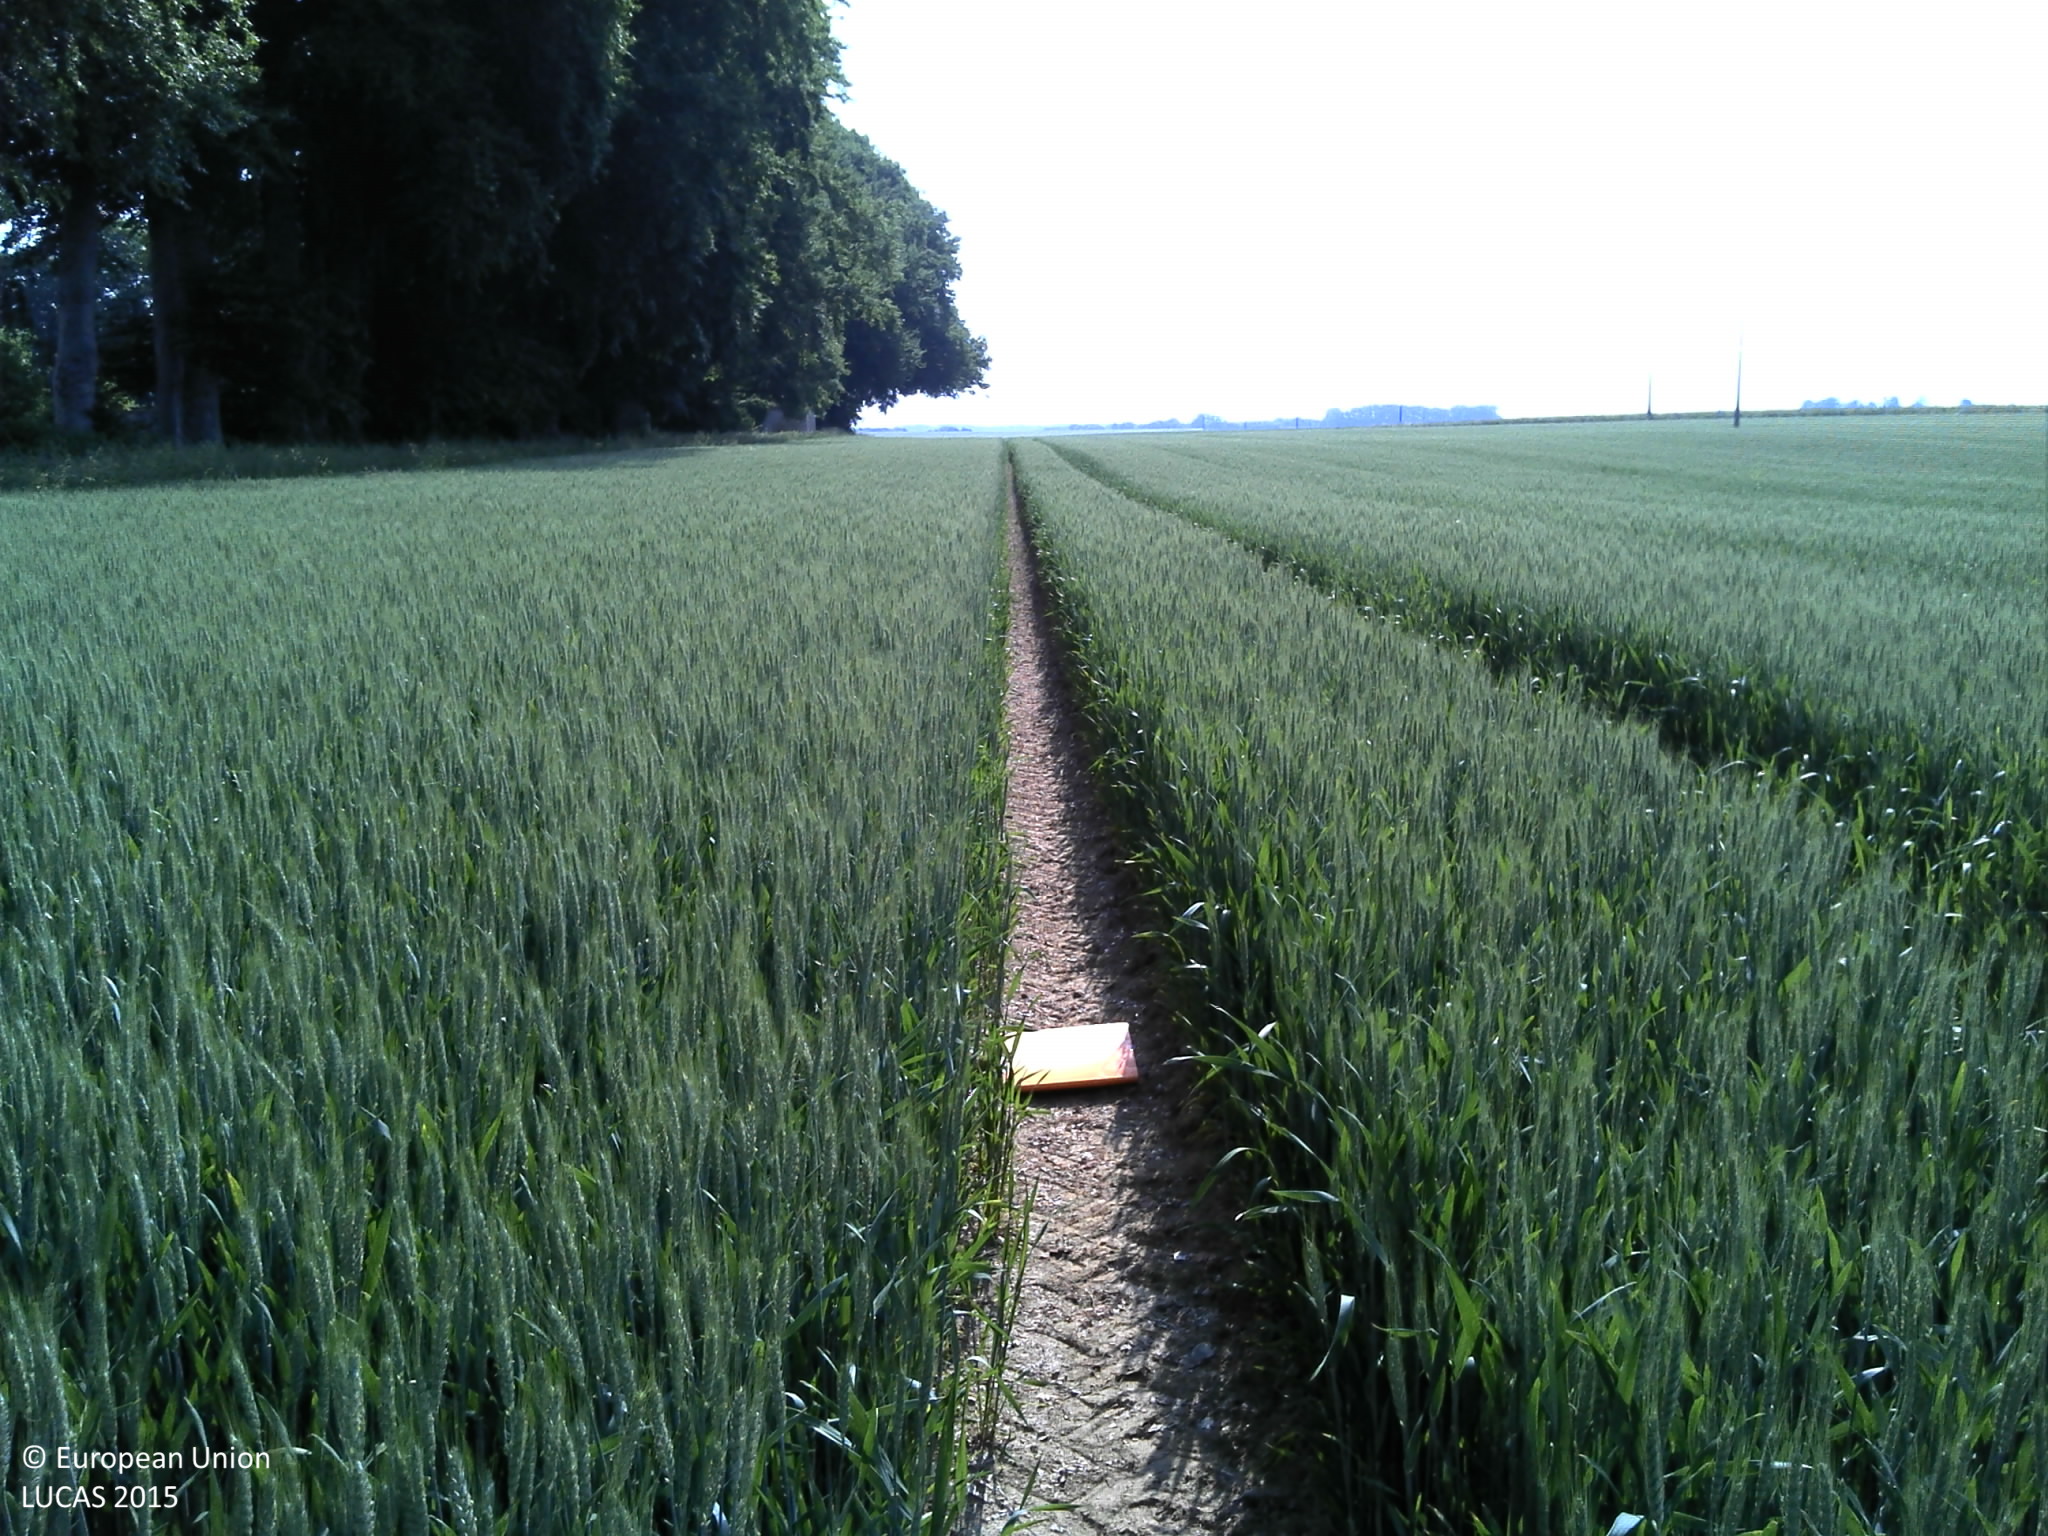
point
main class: Cropland
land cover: Common wheat
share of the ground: > 75 %
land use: Agriculture (excluding fallow land and kitchen gardens)
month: June
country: FR
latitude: 49.7482
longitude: 1.1379
